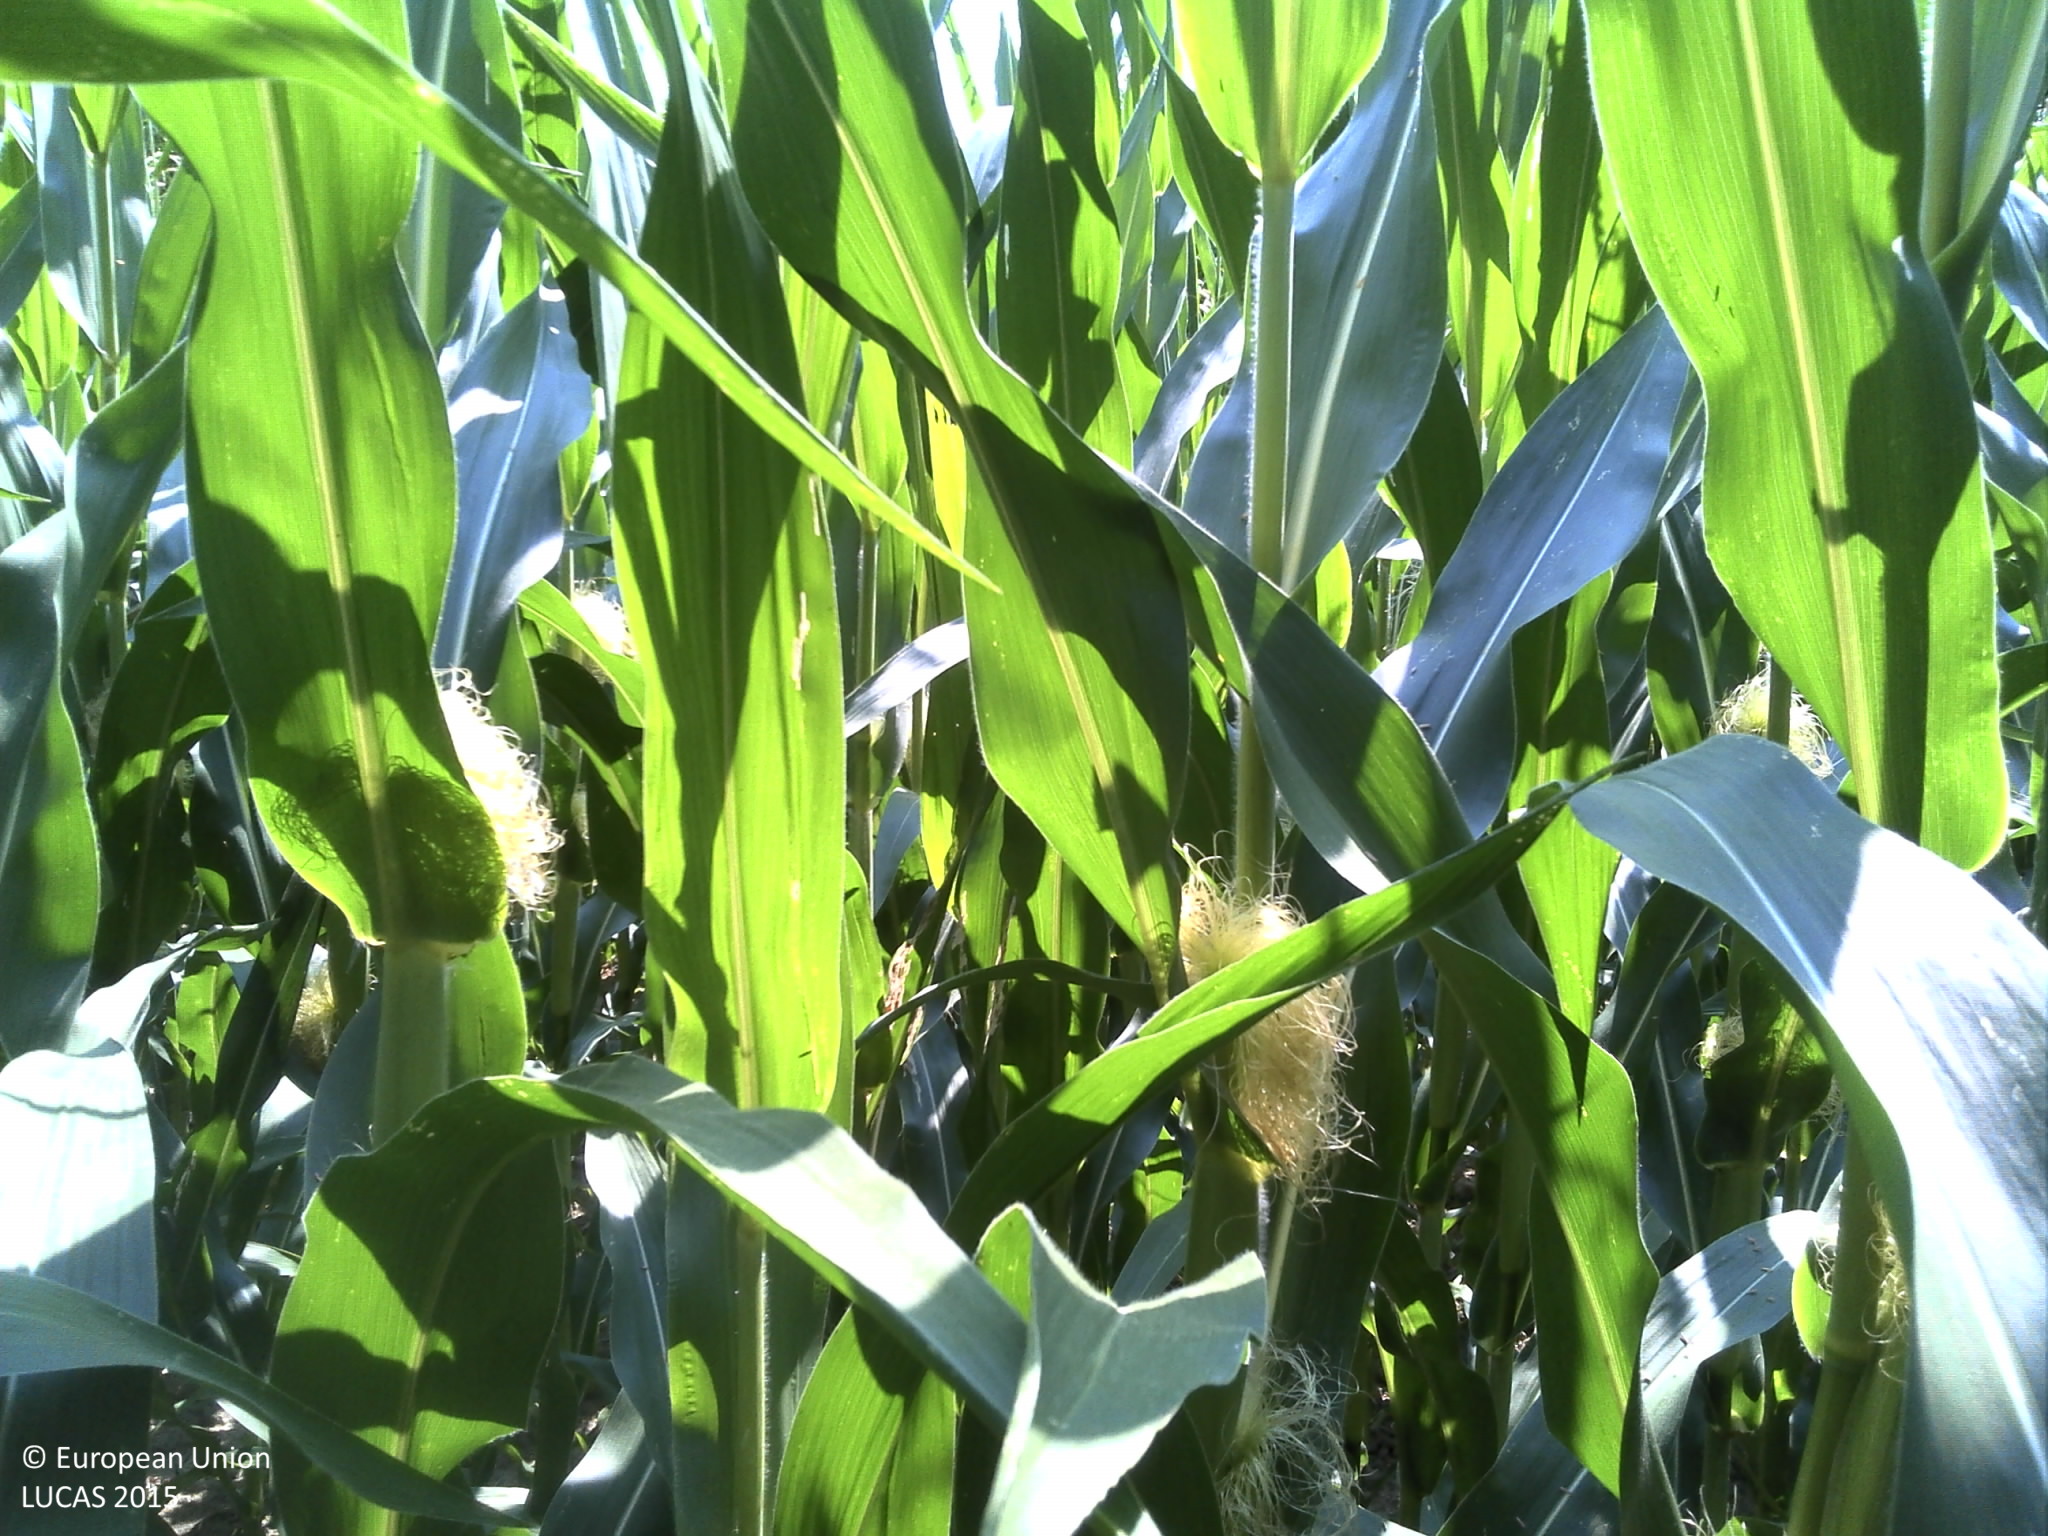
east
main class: Cropland
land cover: Maize
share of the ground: > 75 %
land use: Agriculture (excluding fallow land and kitchen gardens)
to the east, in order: Maize; Shrubland with sparse tree cover; Temporary grasslands; Maize
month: July
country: HR
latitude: 45.8692
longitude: 16.7115
